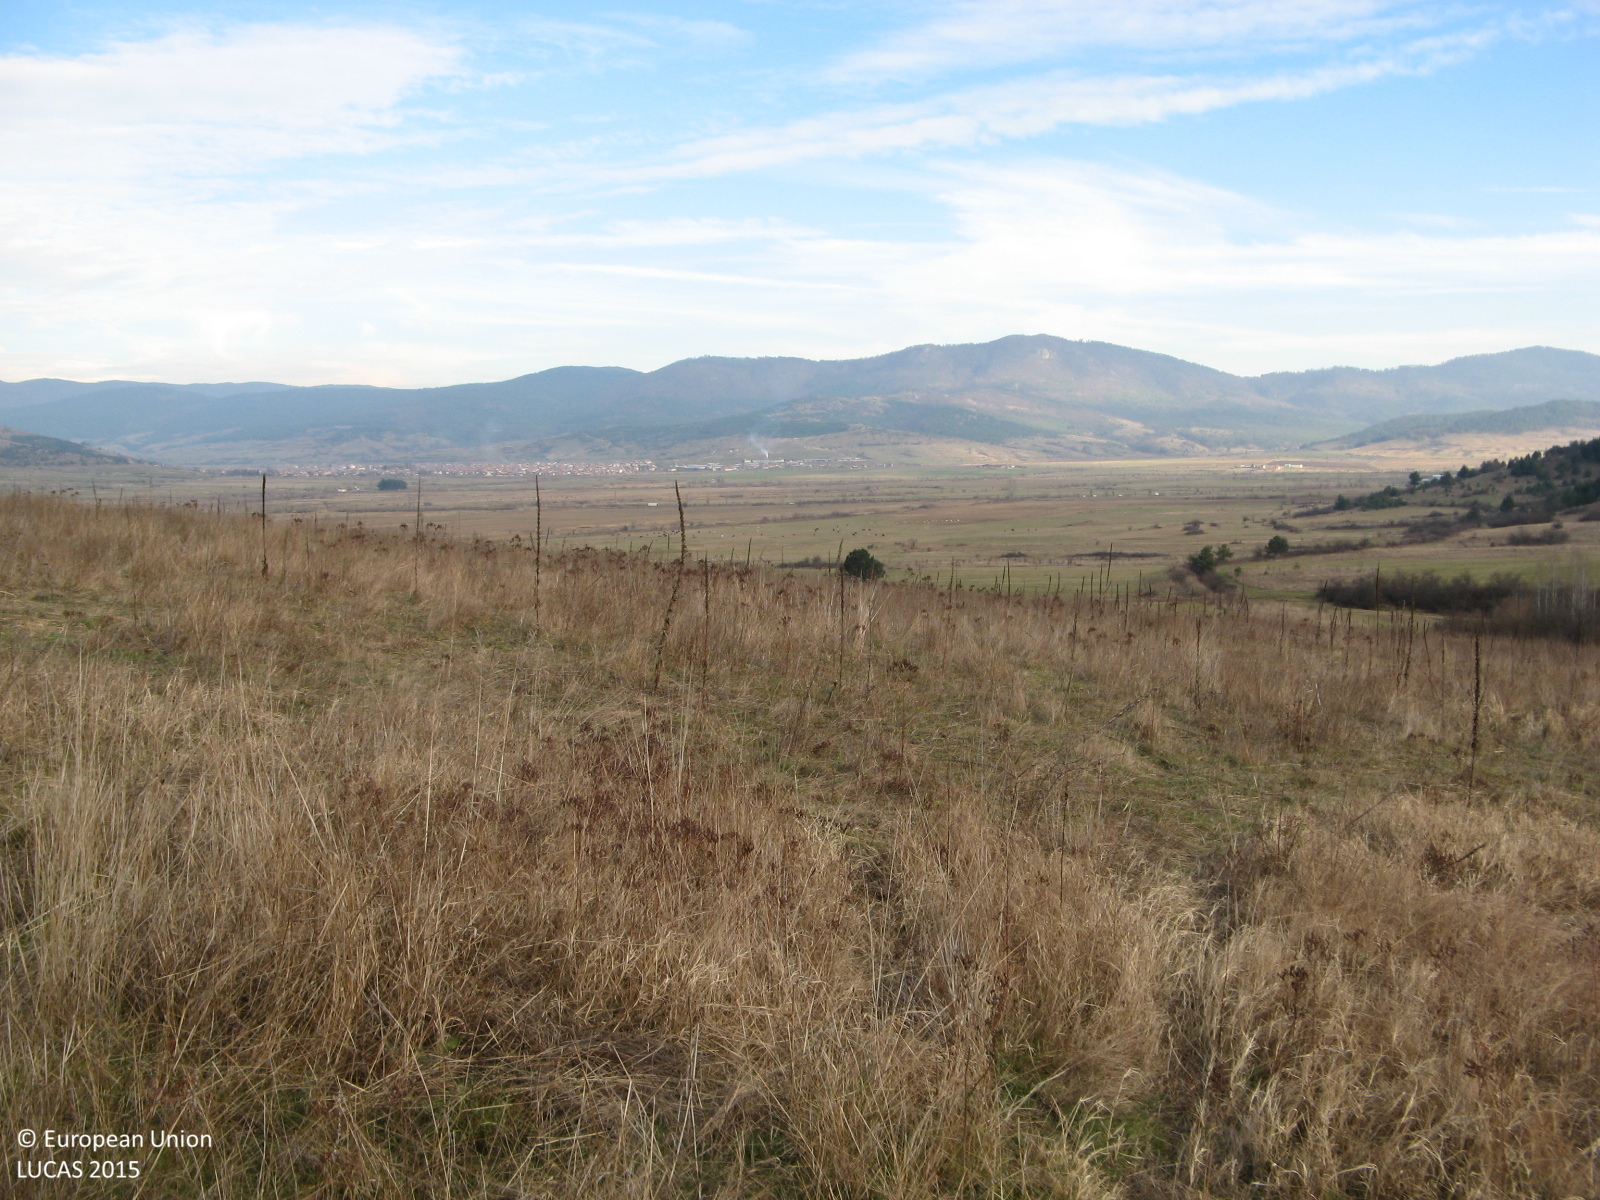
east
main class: Grassland
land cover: Grassland without tree/shrub cover
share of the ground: > 75 %
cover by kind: herbaceous plants 100 %
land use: Agriculture (excluding fallow land and kitchen gardens)
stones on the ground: < 10 %
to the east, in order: Grassland without tree/shrub cover; Grassland with sparse tree/shrub cover
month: December
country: BG
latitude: 42.0158
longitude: 24.0582
